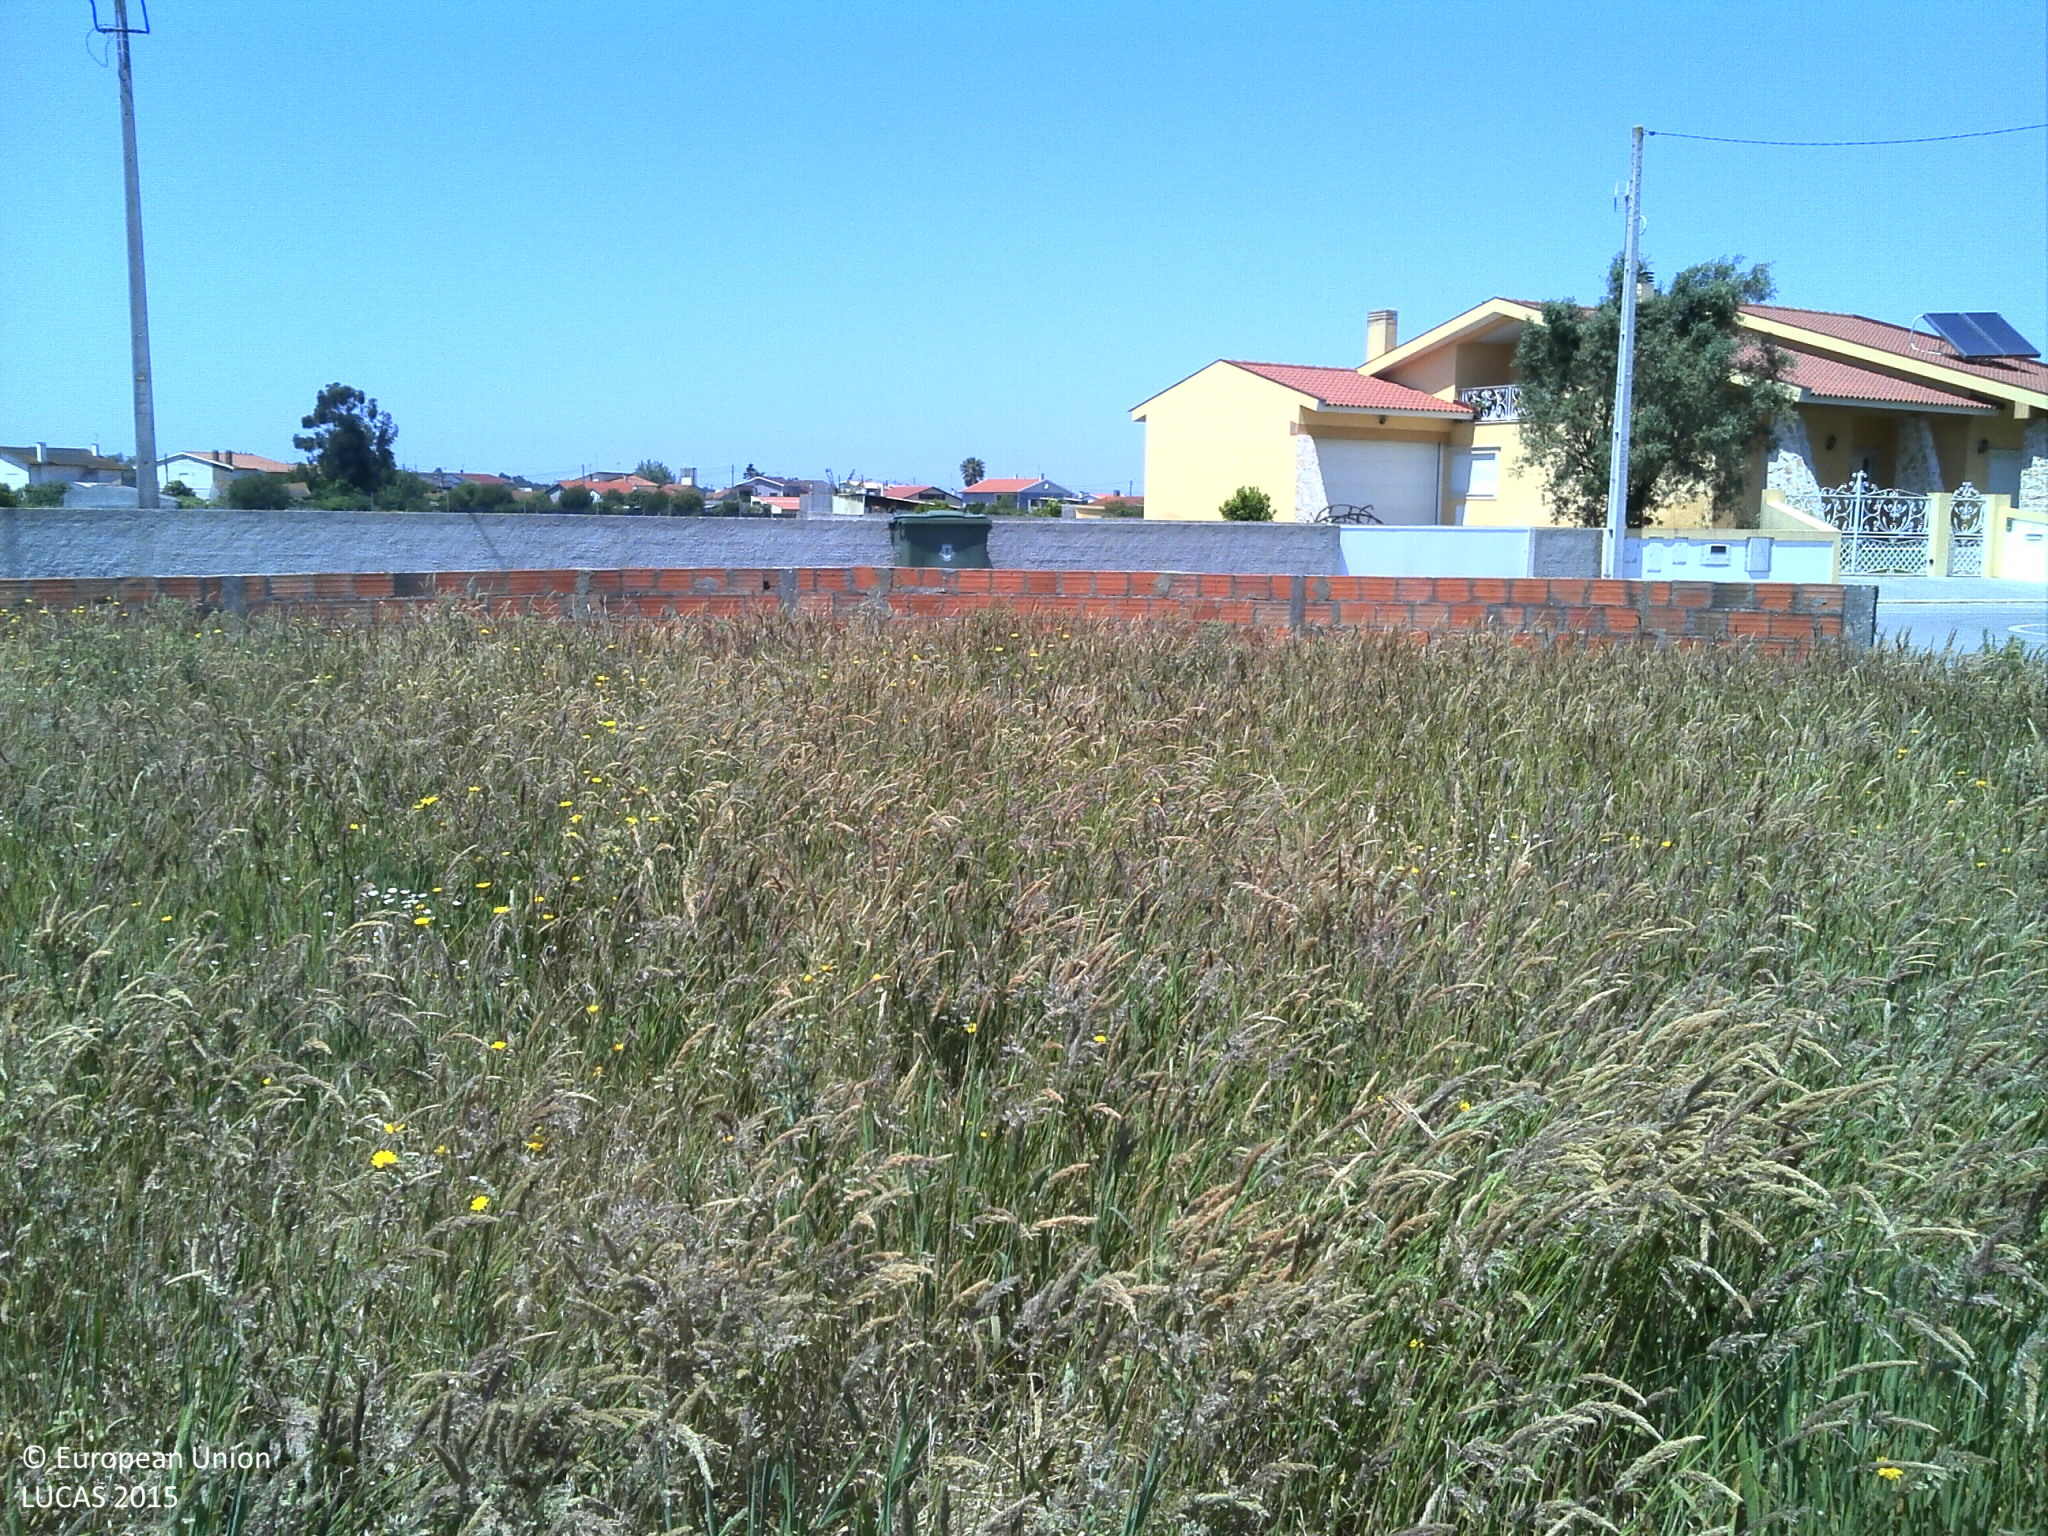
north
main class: Grassland
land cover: Grassland without tree/shrub cover
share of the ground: 50 - 75 %
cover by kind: herbaceous plants 75 %, unconsolidated bare surface 25 %
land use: Agriculture (excluding fallow land and kitchen gardens)
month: May
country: PT
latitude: 40.4693
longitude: -8.6956
